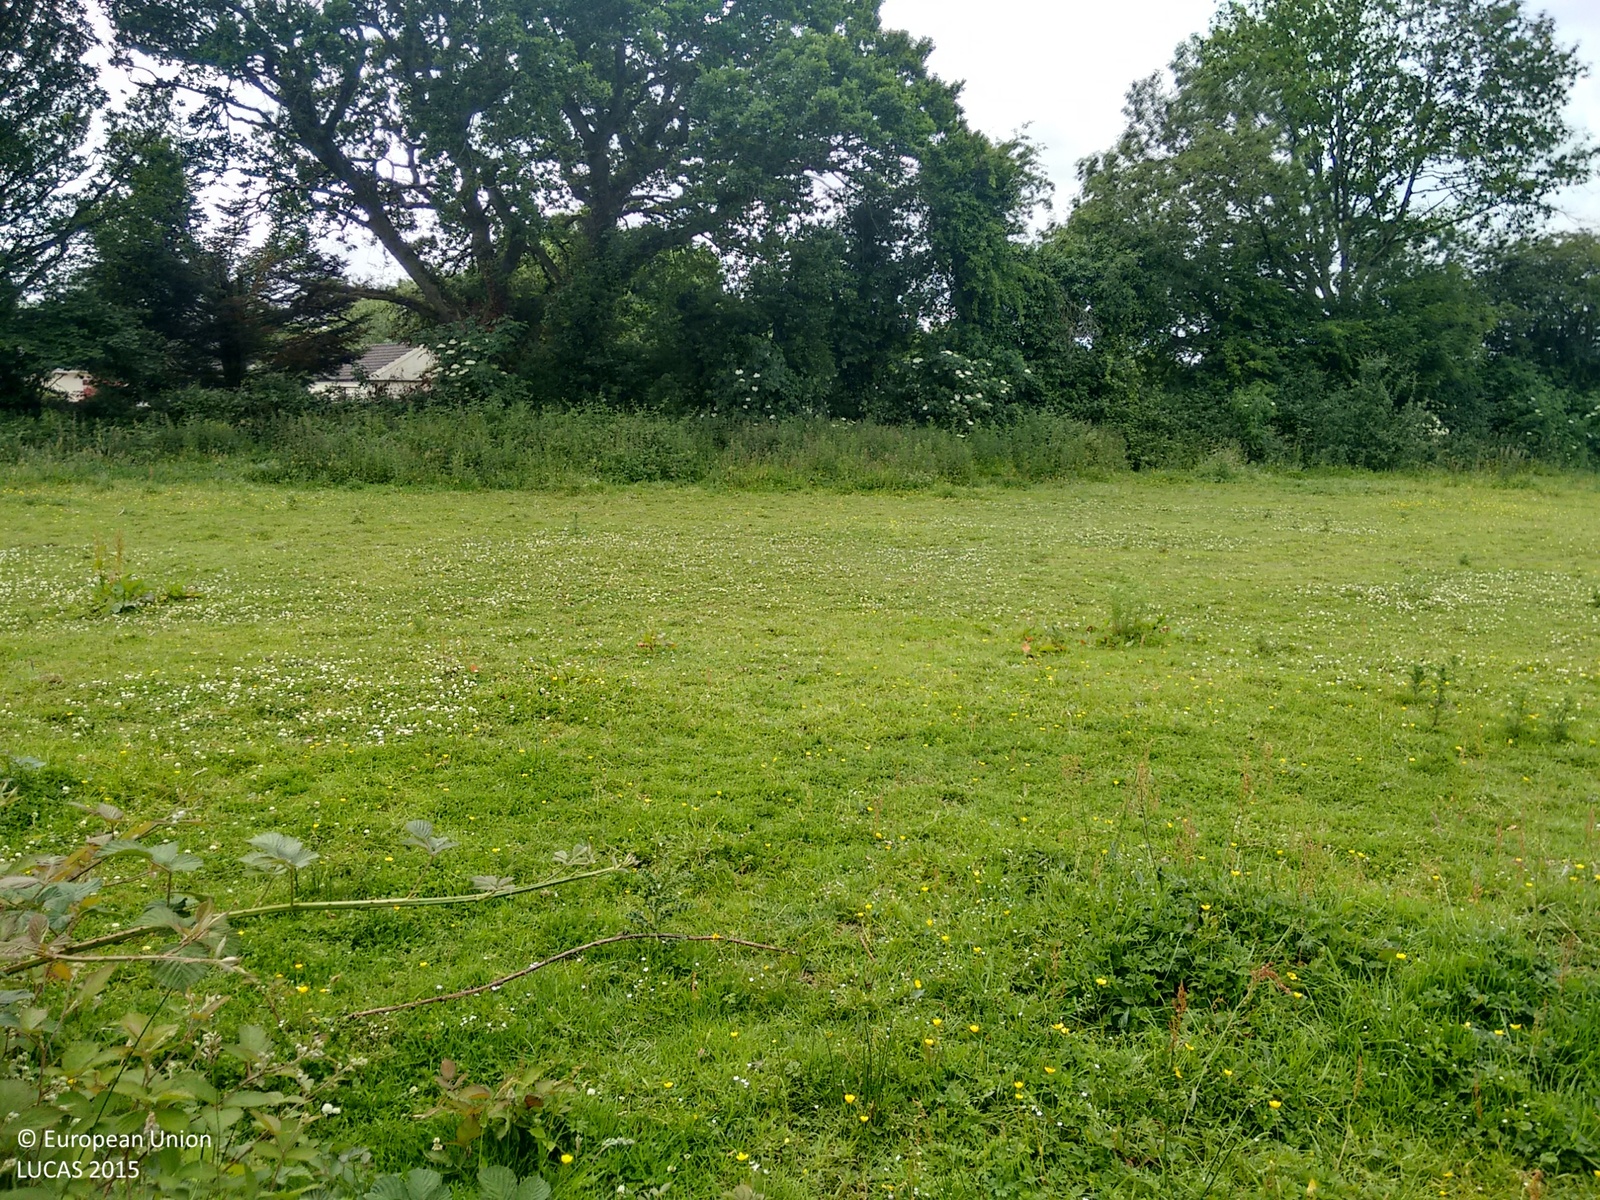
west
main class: Grassland
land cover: Grassland without tree/shrub cover
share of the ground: > 75 %
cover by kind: herbaceous plants 95 %, shrubs 5 %
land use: Agriculture (excluding fallow land and kitchen gardens)
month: July
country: IE
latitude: 52.2559
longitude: -8.2479
